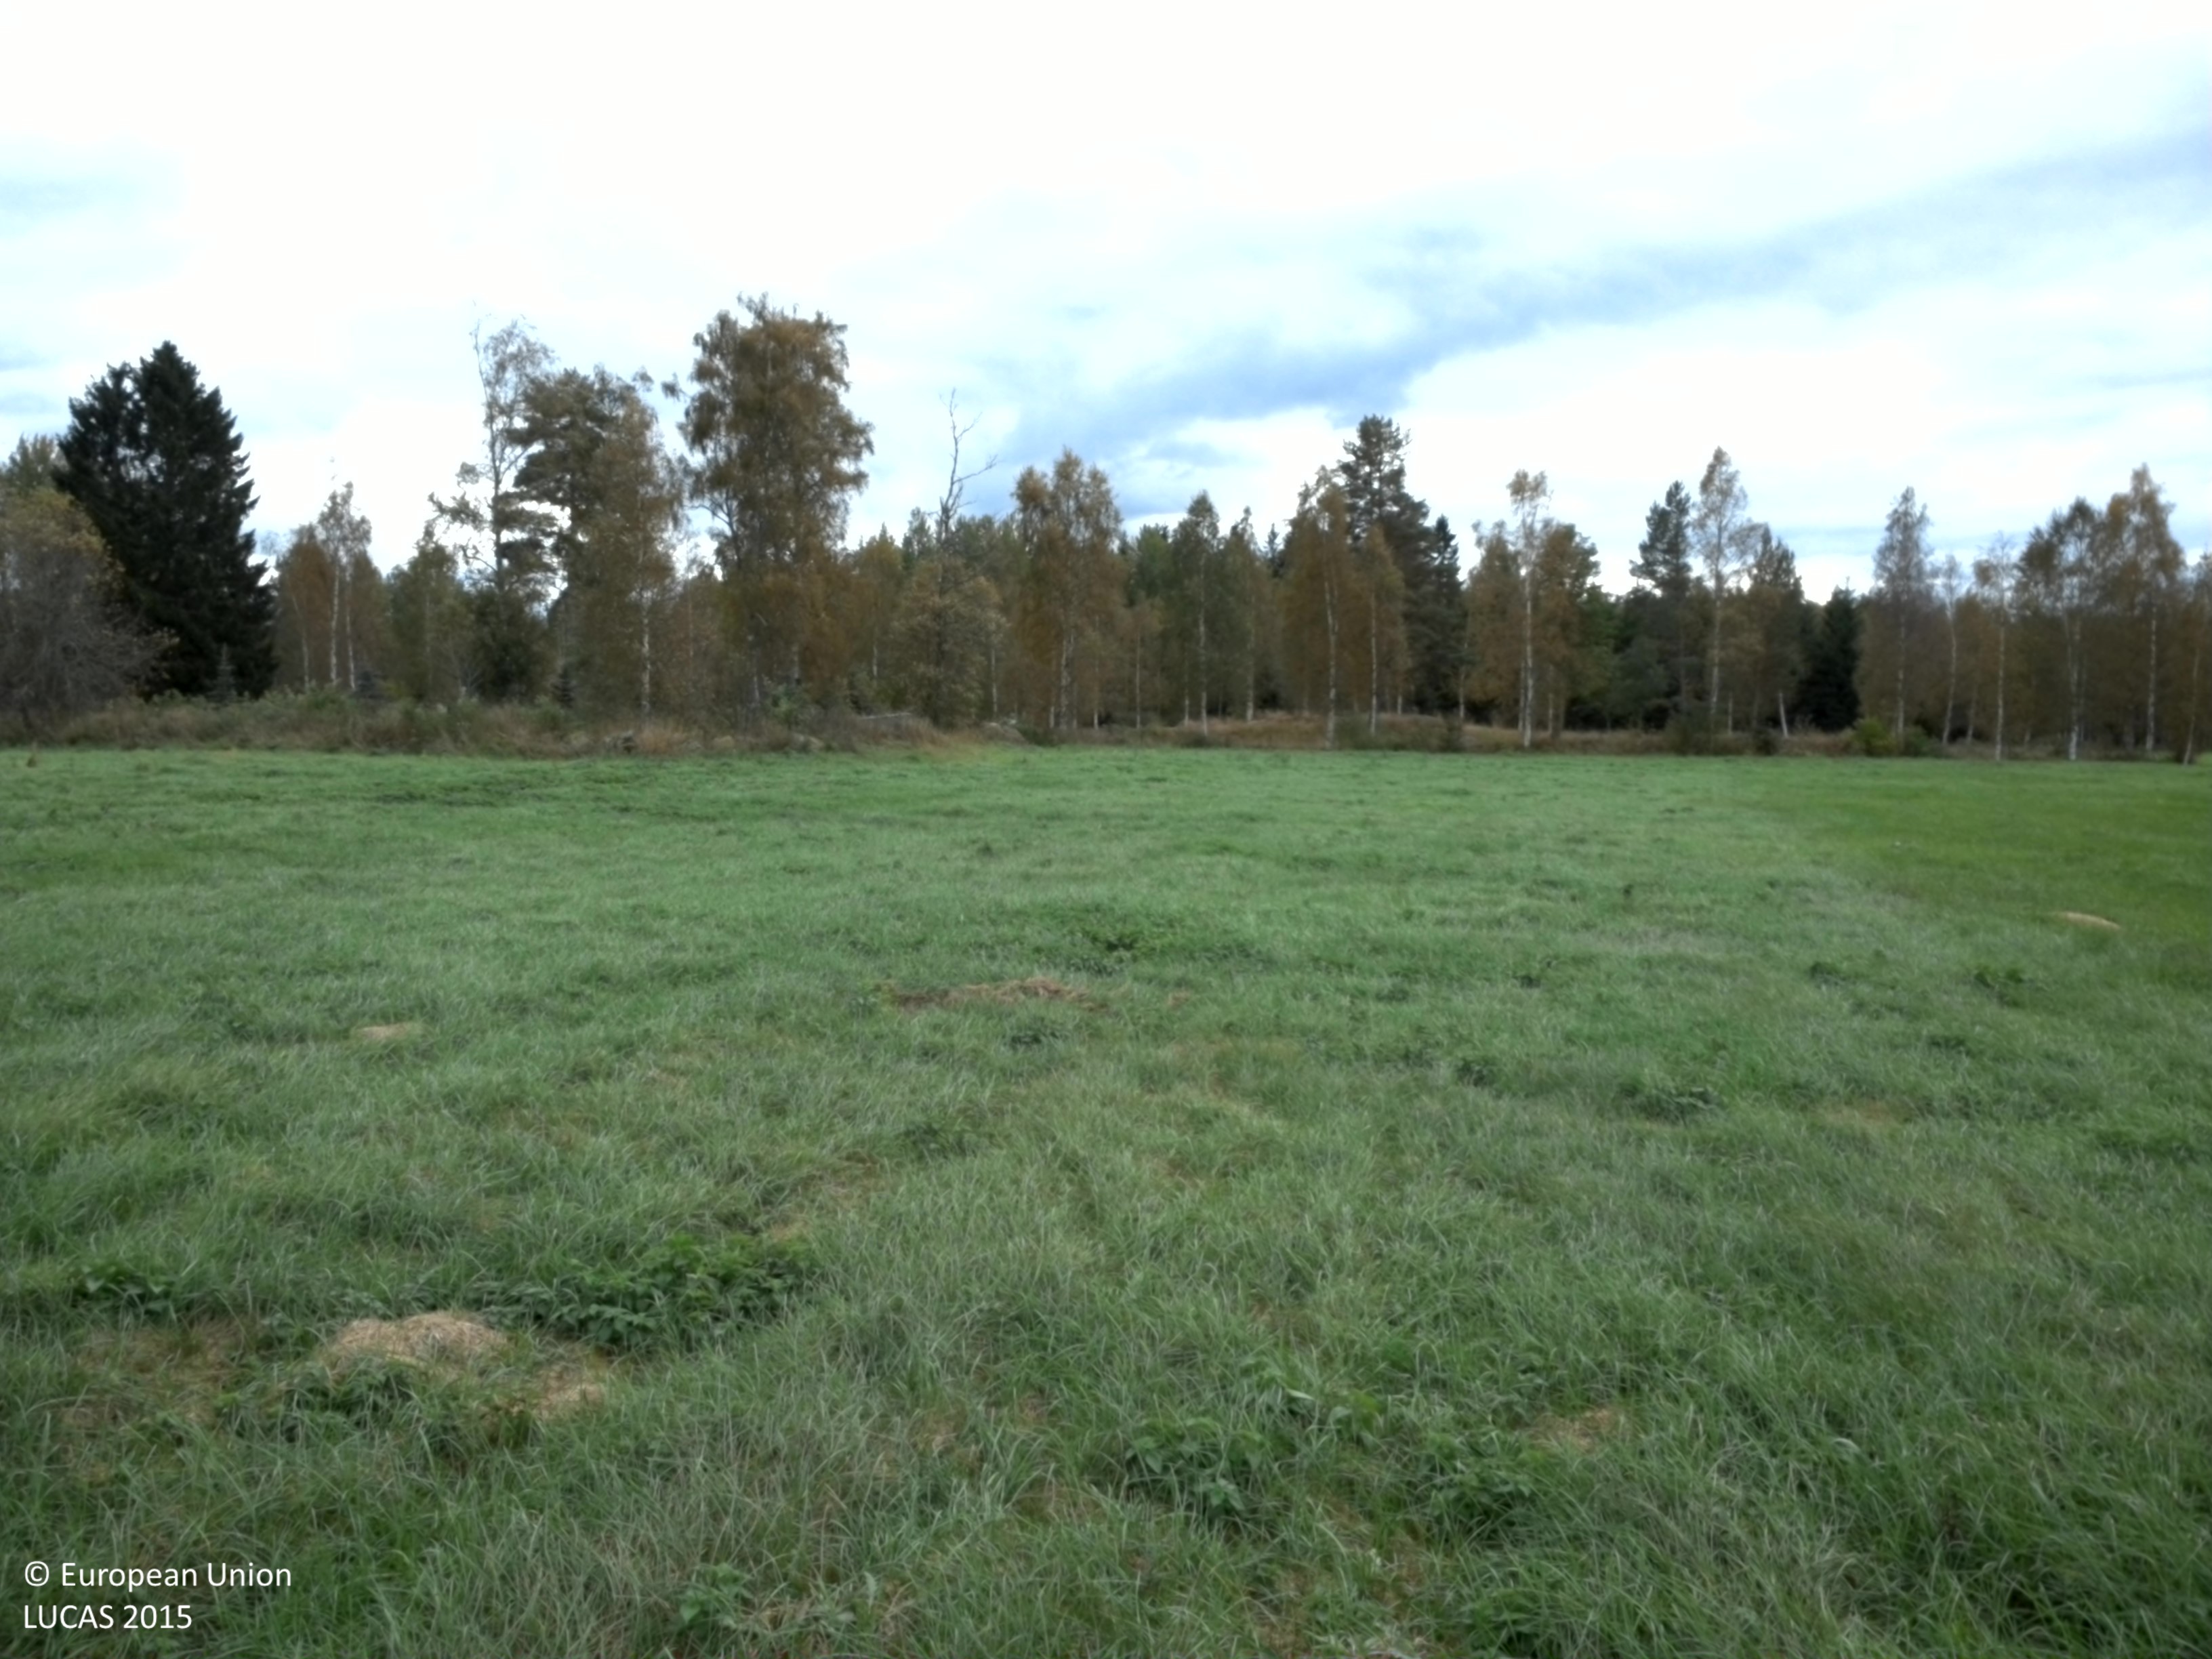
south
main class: Grassland
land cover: Grassland without tree/shrub cover
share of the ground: > 75 %
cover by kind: herbaceous plants 100 %
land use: Agriculture (excluding fallow land and kitchen gardens)
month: September
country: SE
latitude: 60.1874
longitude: 17.0054
